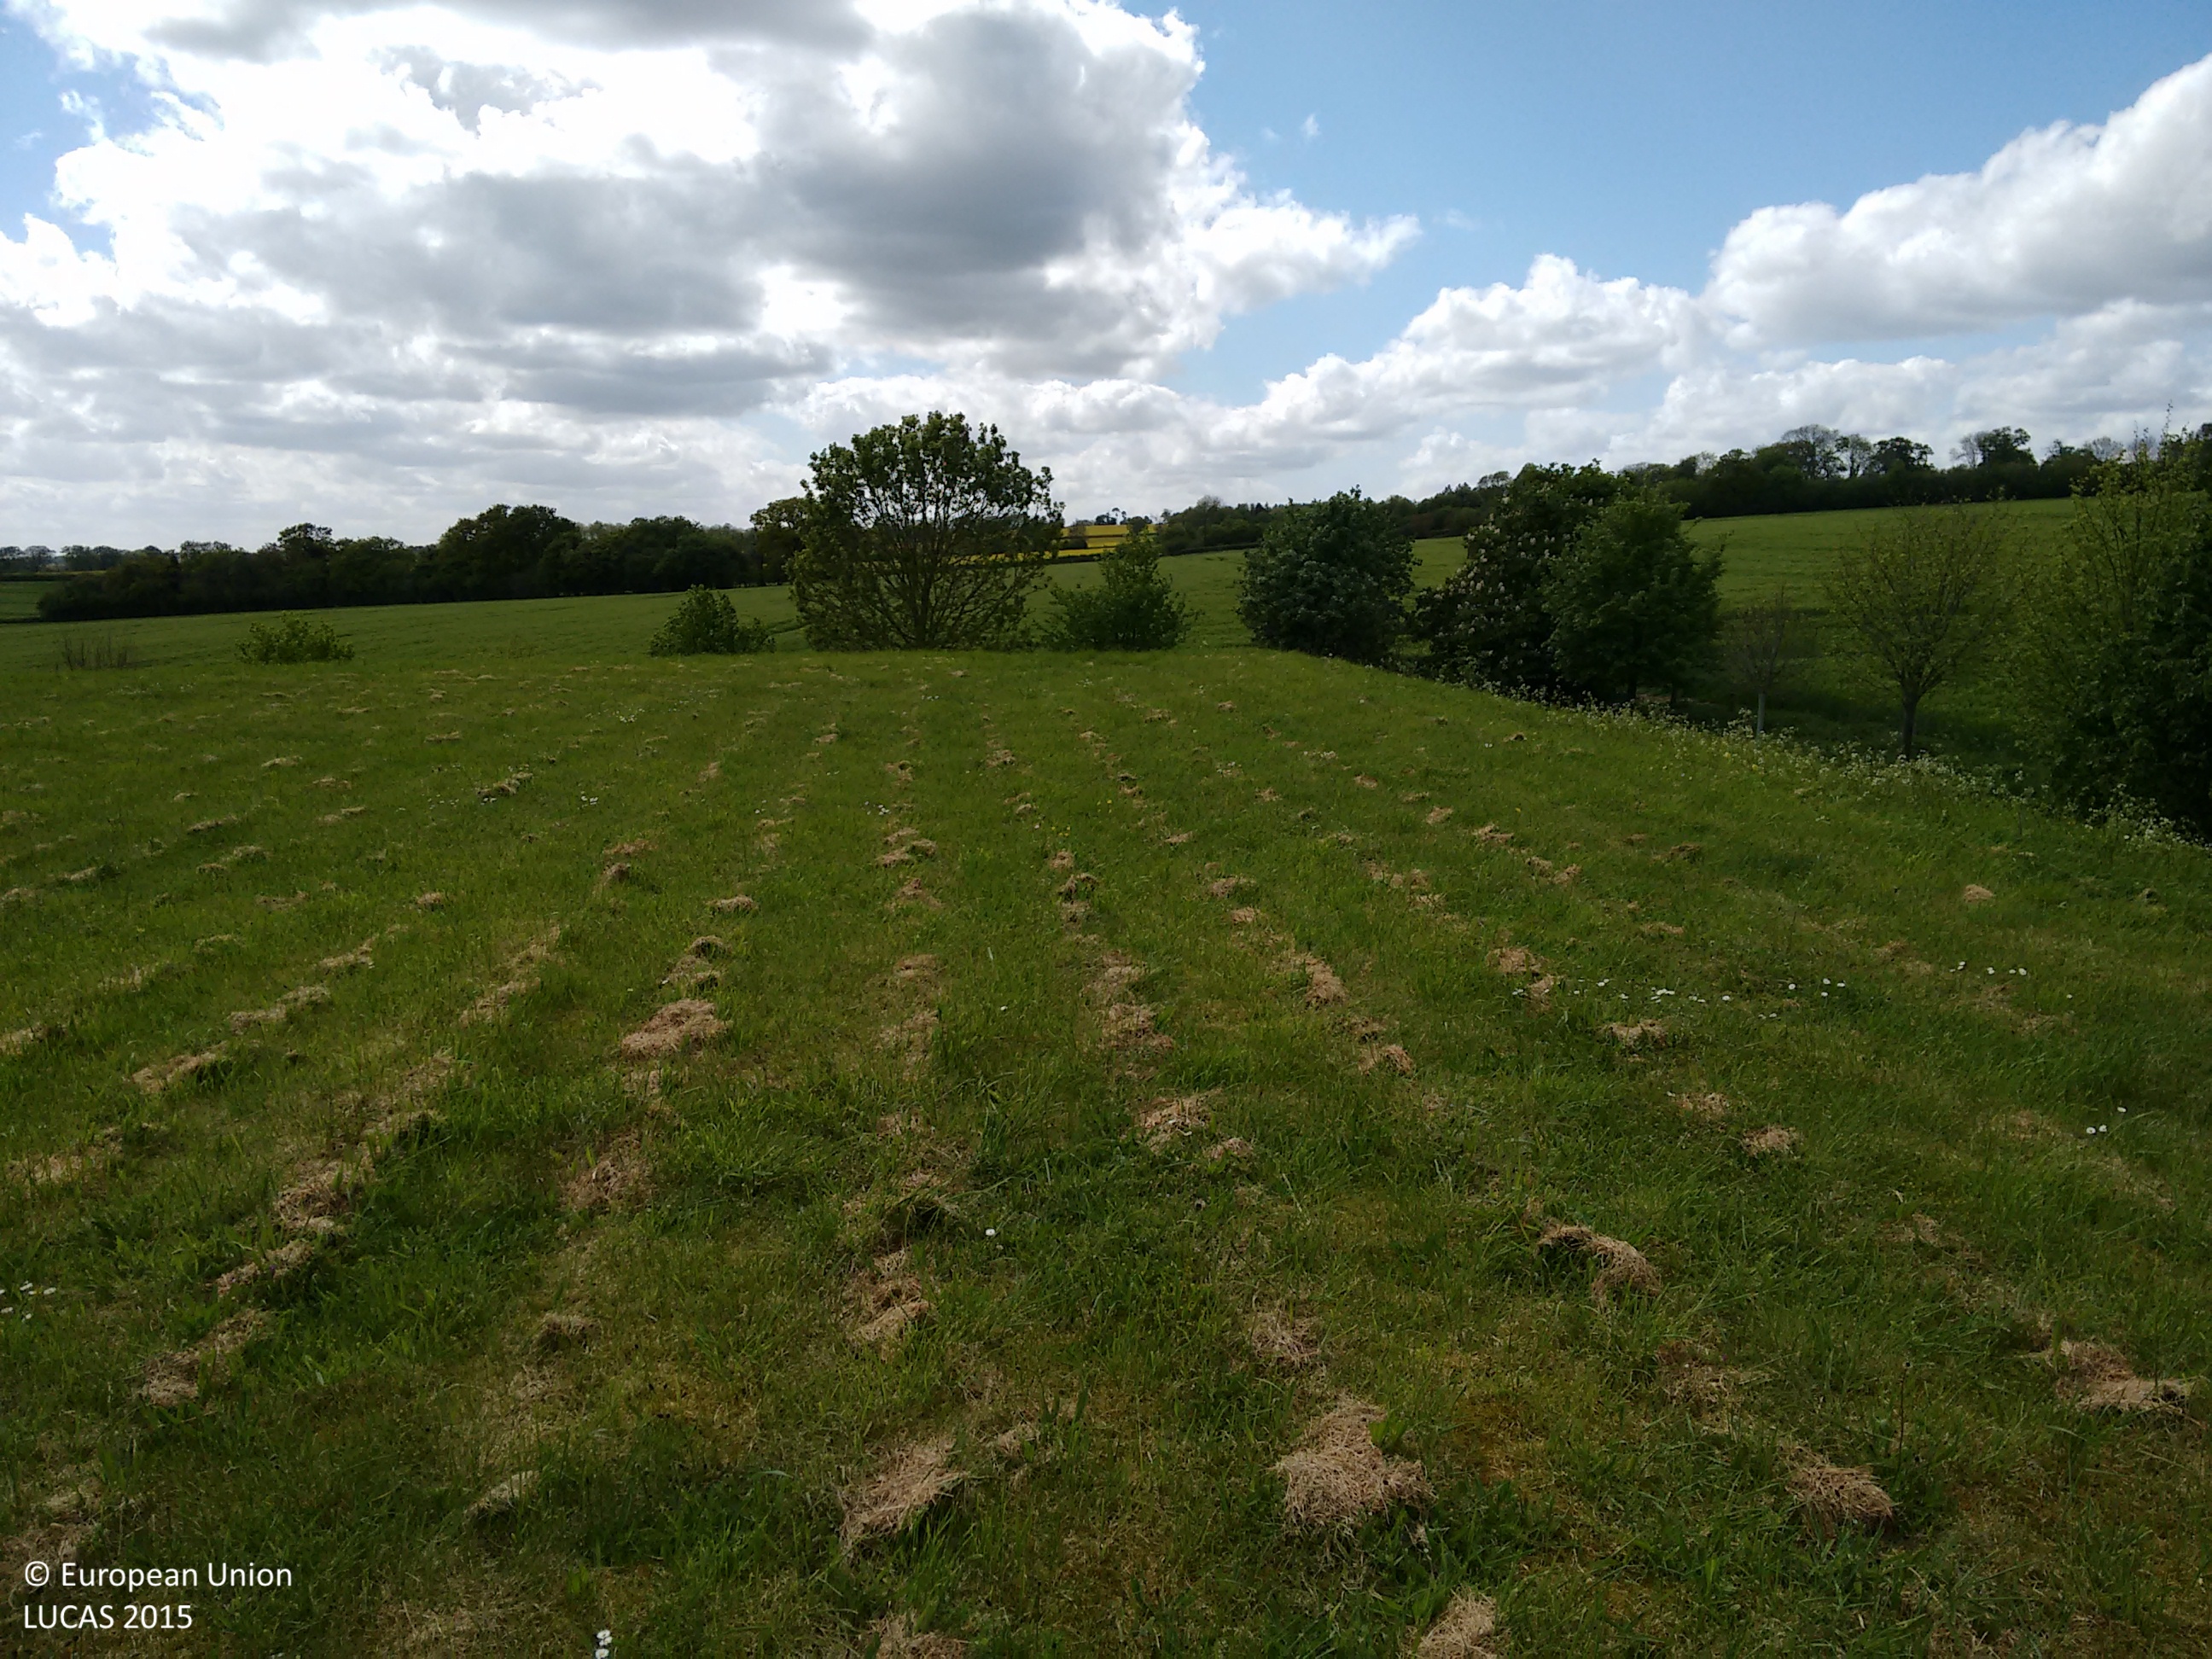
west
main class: Grassland
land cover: Grassland without tree/shrub cover
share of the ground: > 75 %
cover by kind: herbaceous plants 100 %
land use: Semi-natural and natural areas not in use
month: May
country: GB
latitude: 51.2867
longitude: -1.1589
